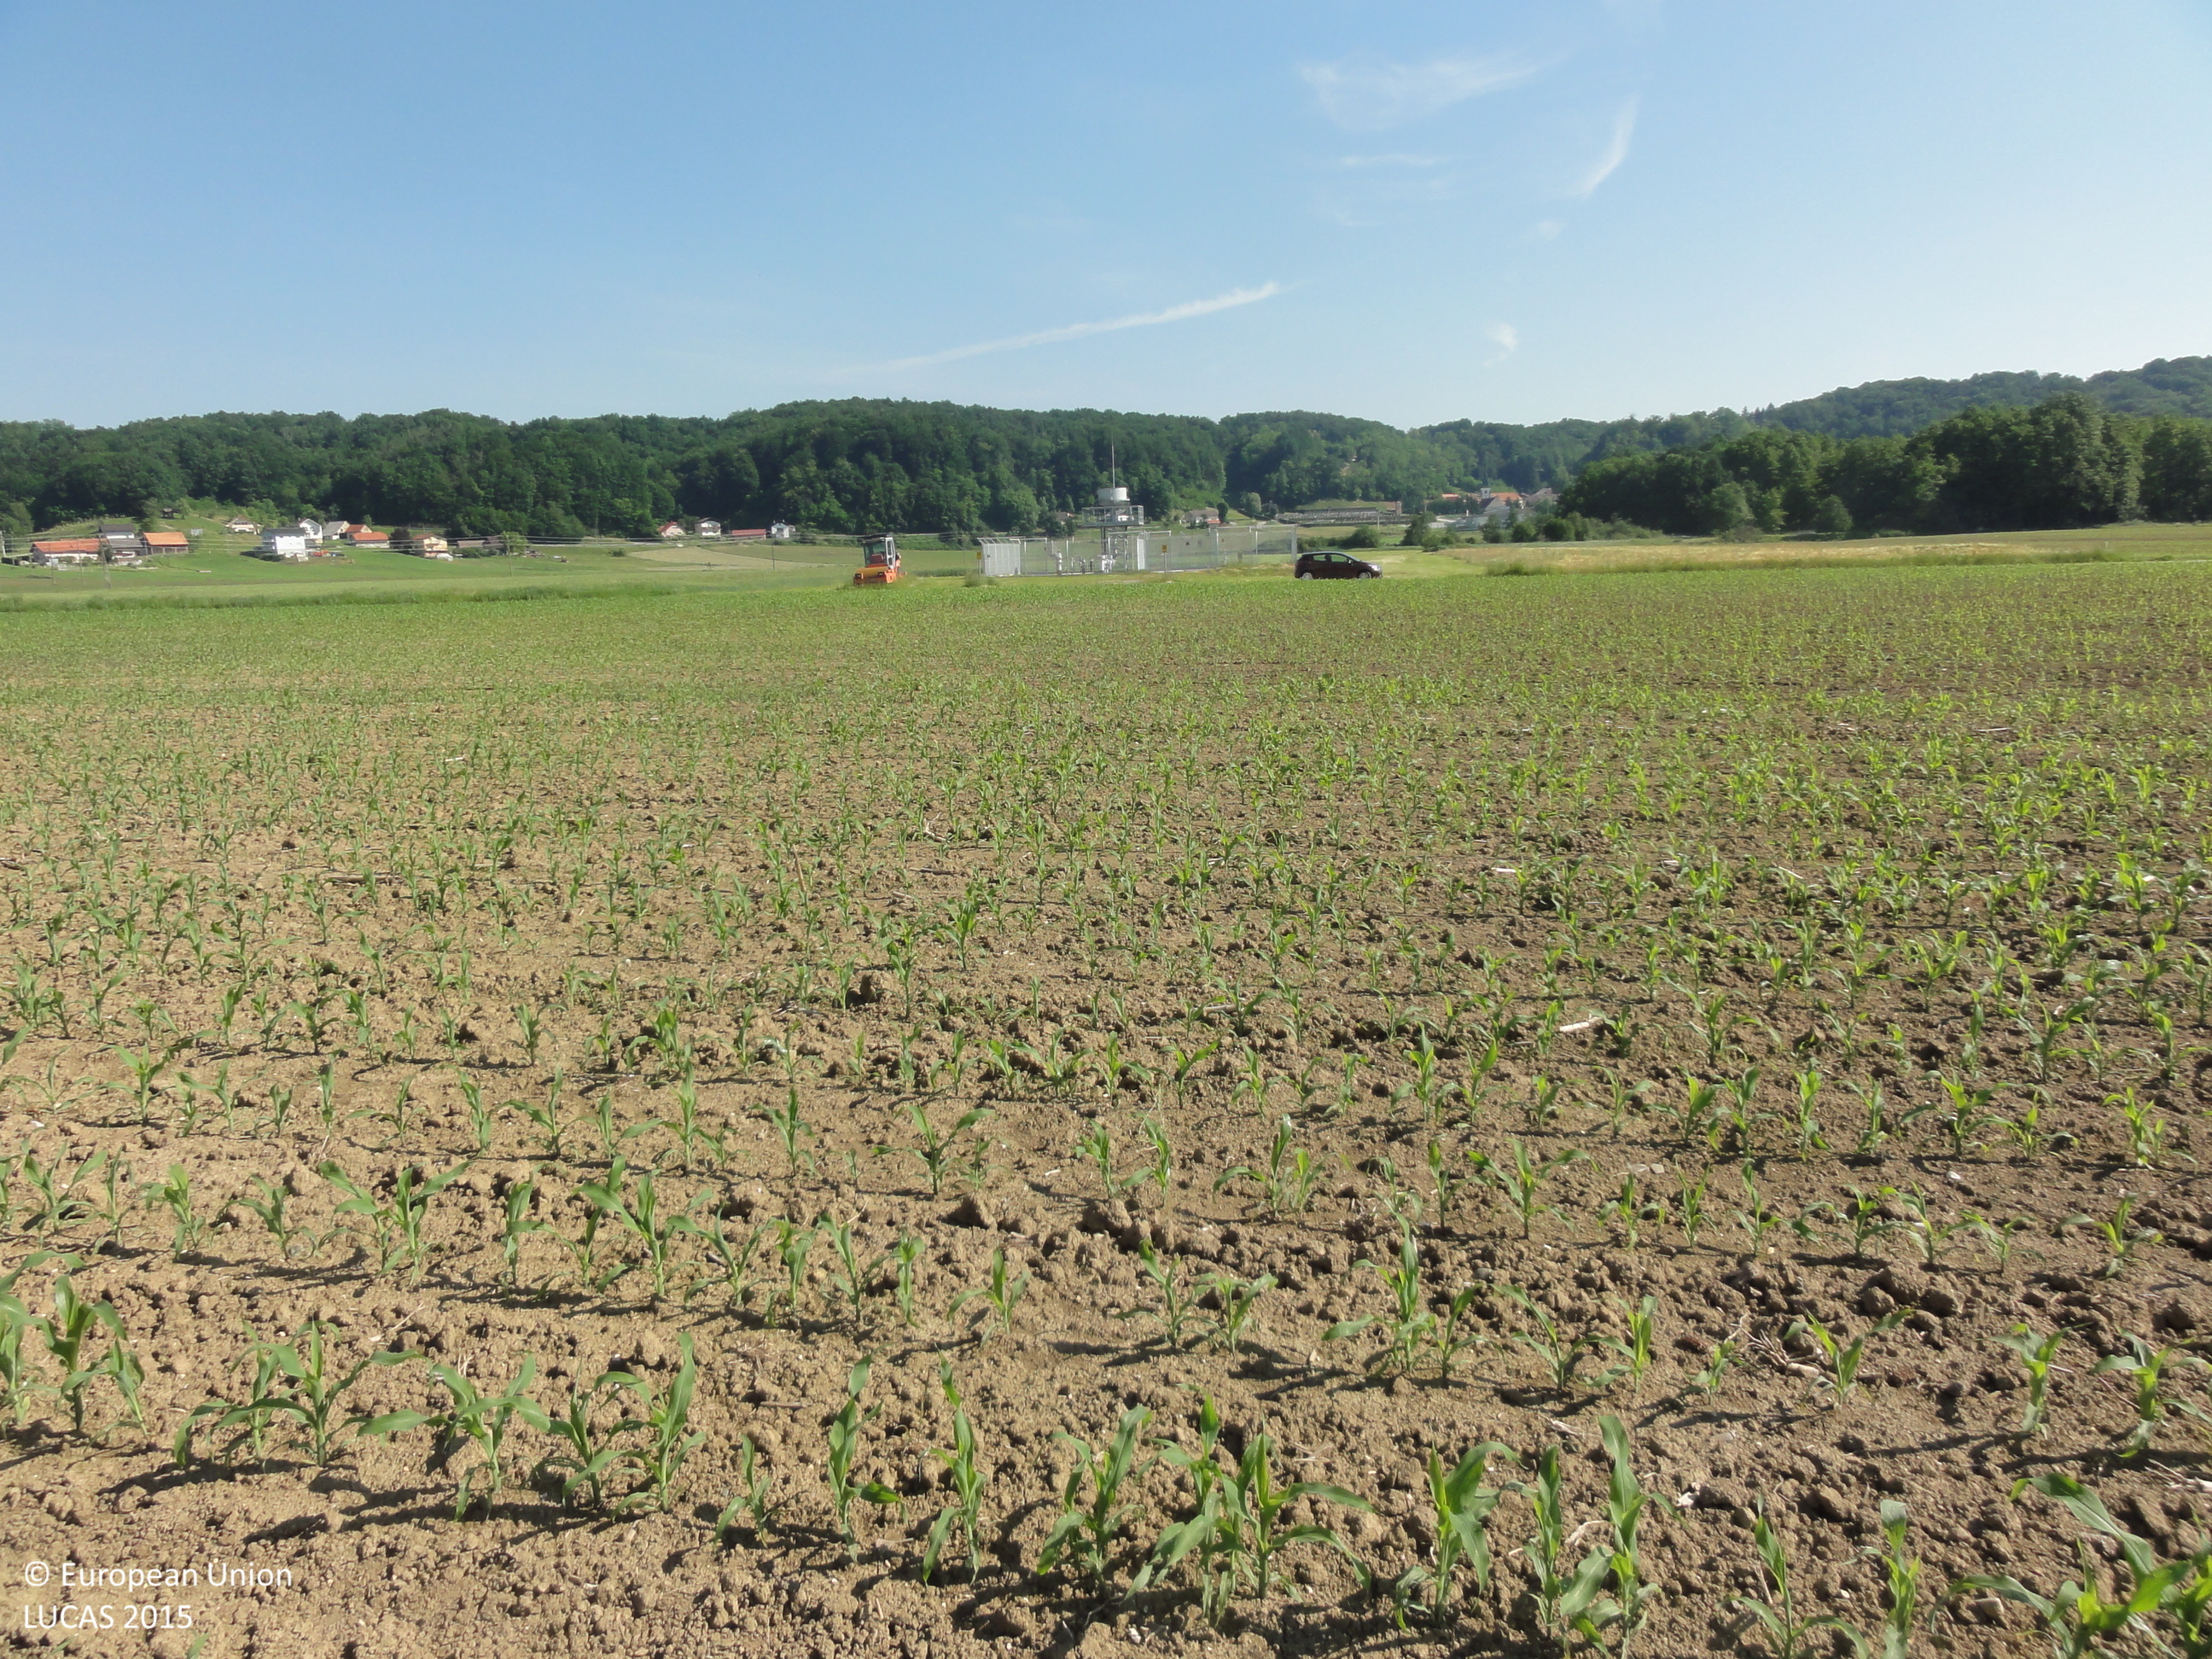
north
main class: Cropland
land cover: Common wheat
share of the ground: > 75 %
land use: Agriculture (excluding fallow land and kitchen gardens)
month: June
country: SI
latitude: 46.3421
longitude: 15.7285
